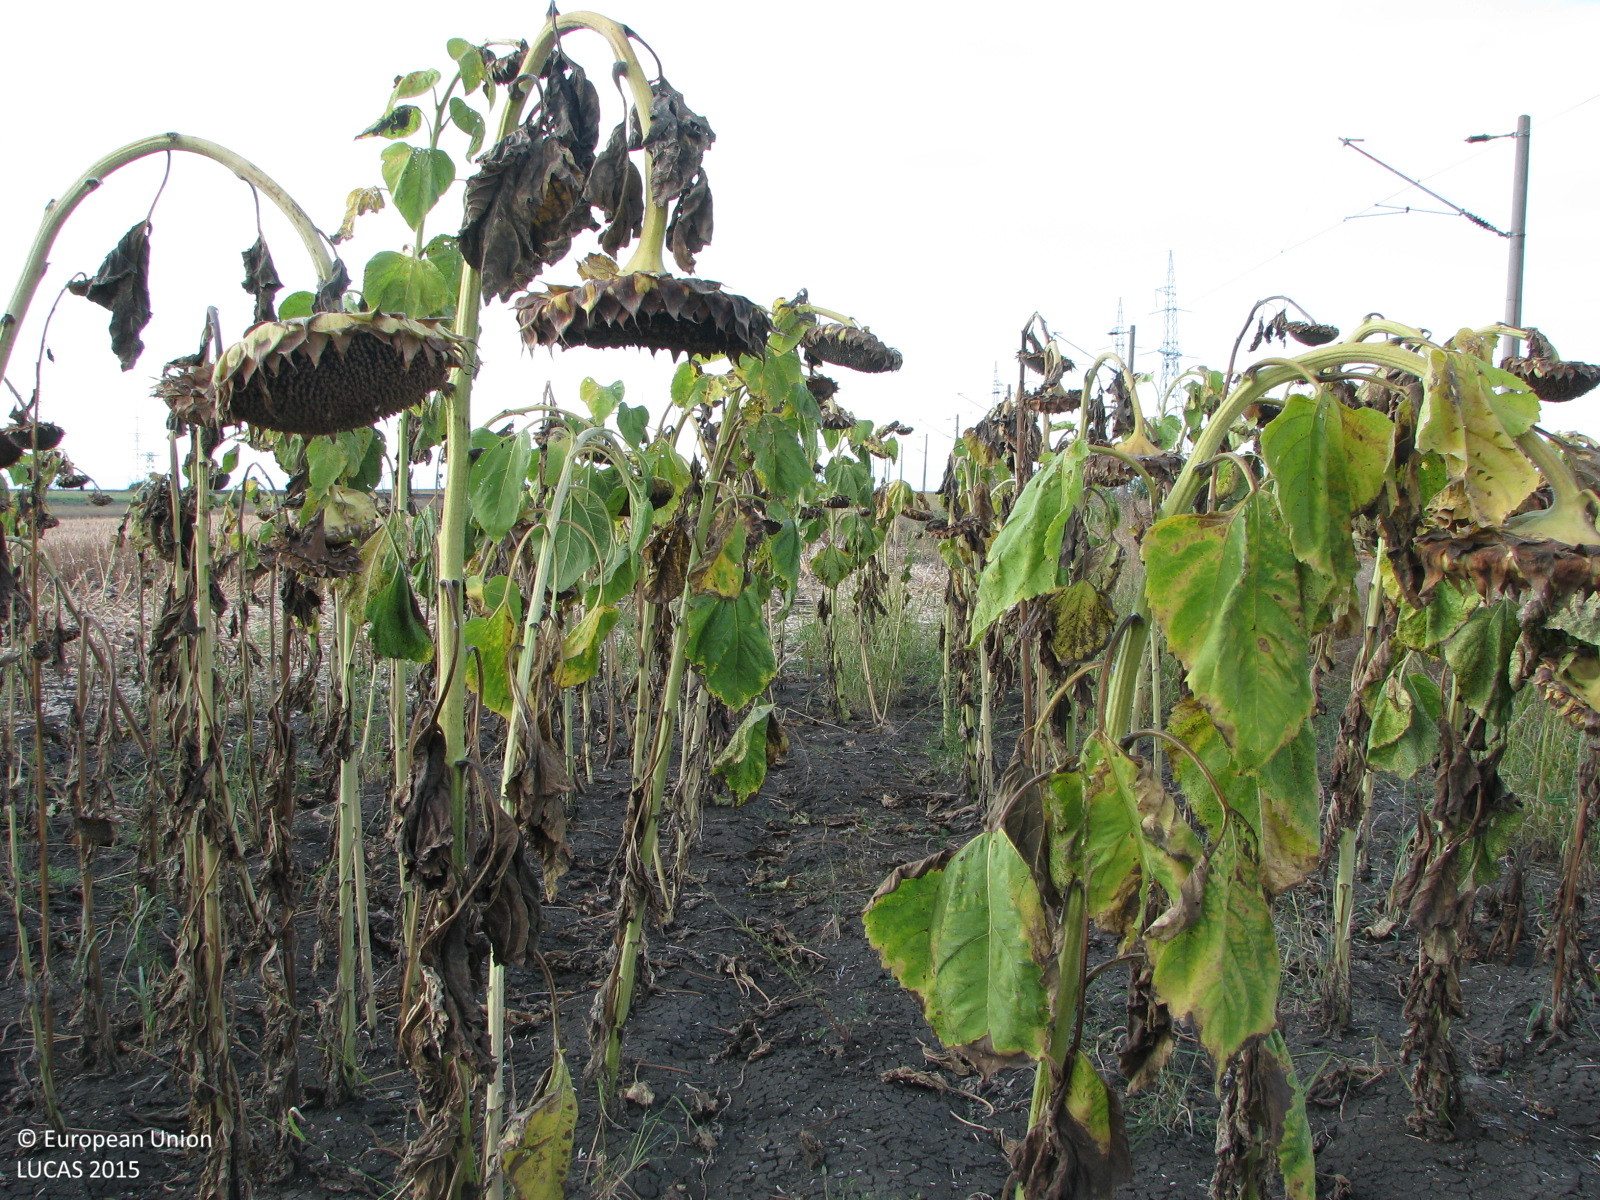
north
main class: Cropland
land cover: Common wheat
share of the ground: > 75 %
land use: Agriculture (excluding fallow land and kitchen gardens)
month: September
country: BG
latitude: 42.2831
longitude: 26.0501
